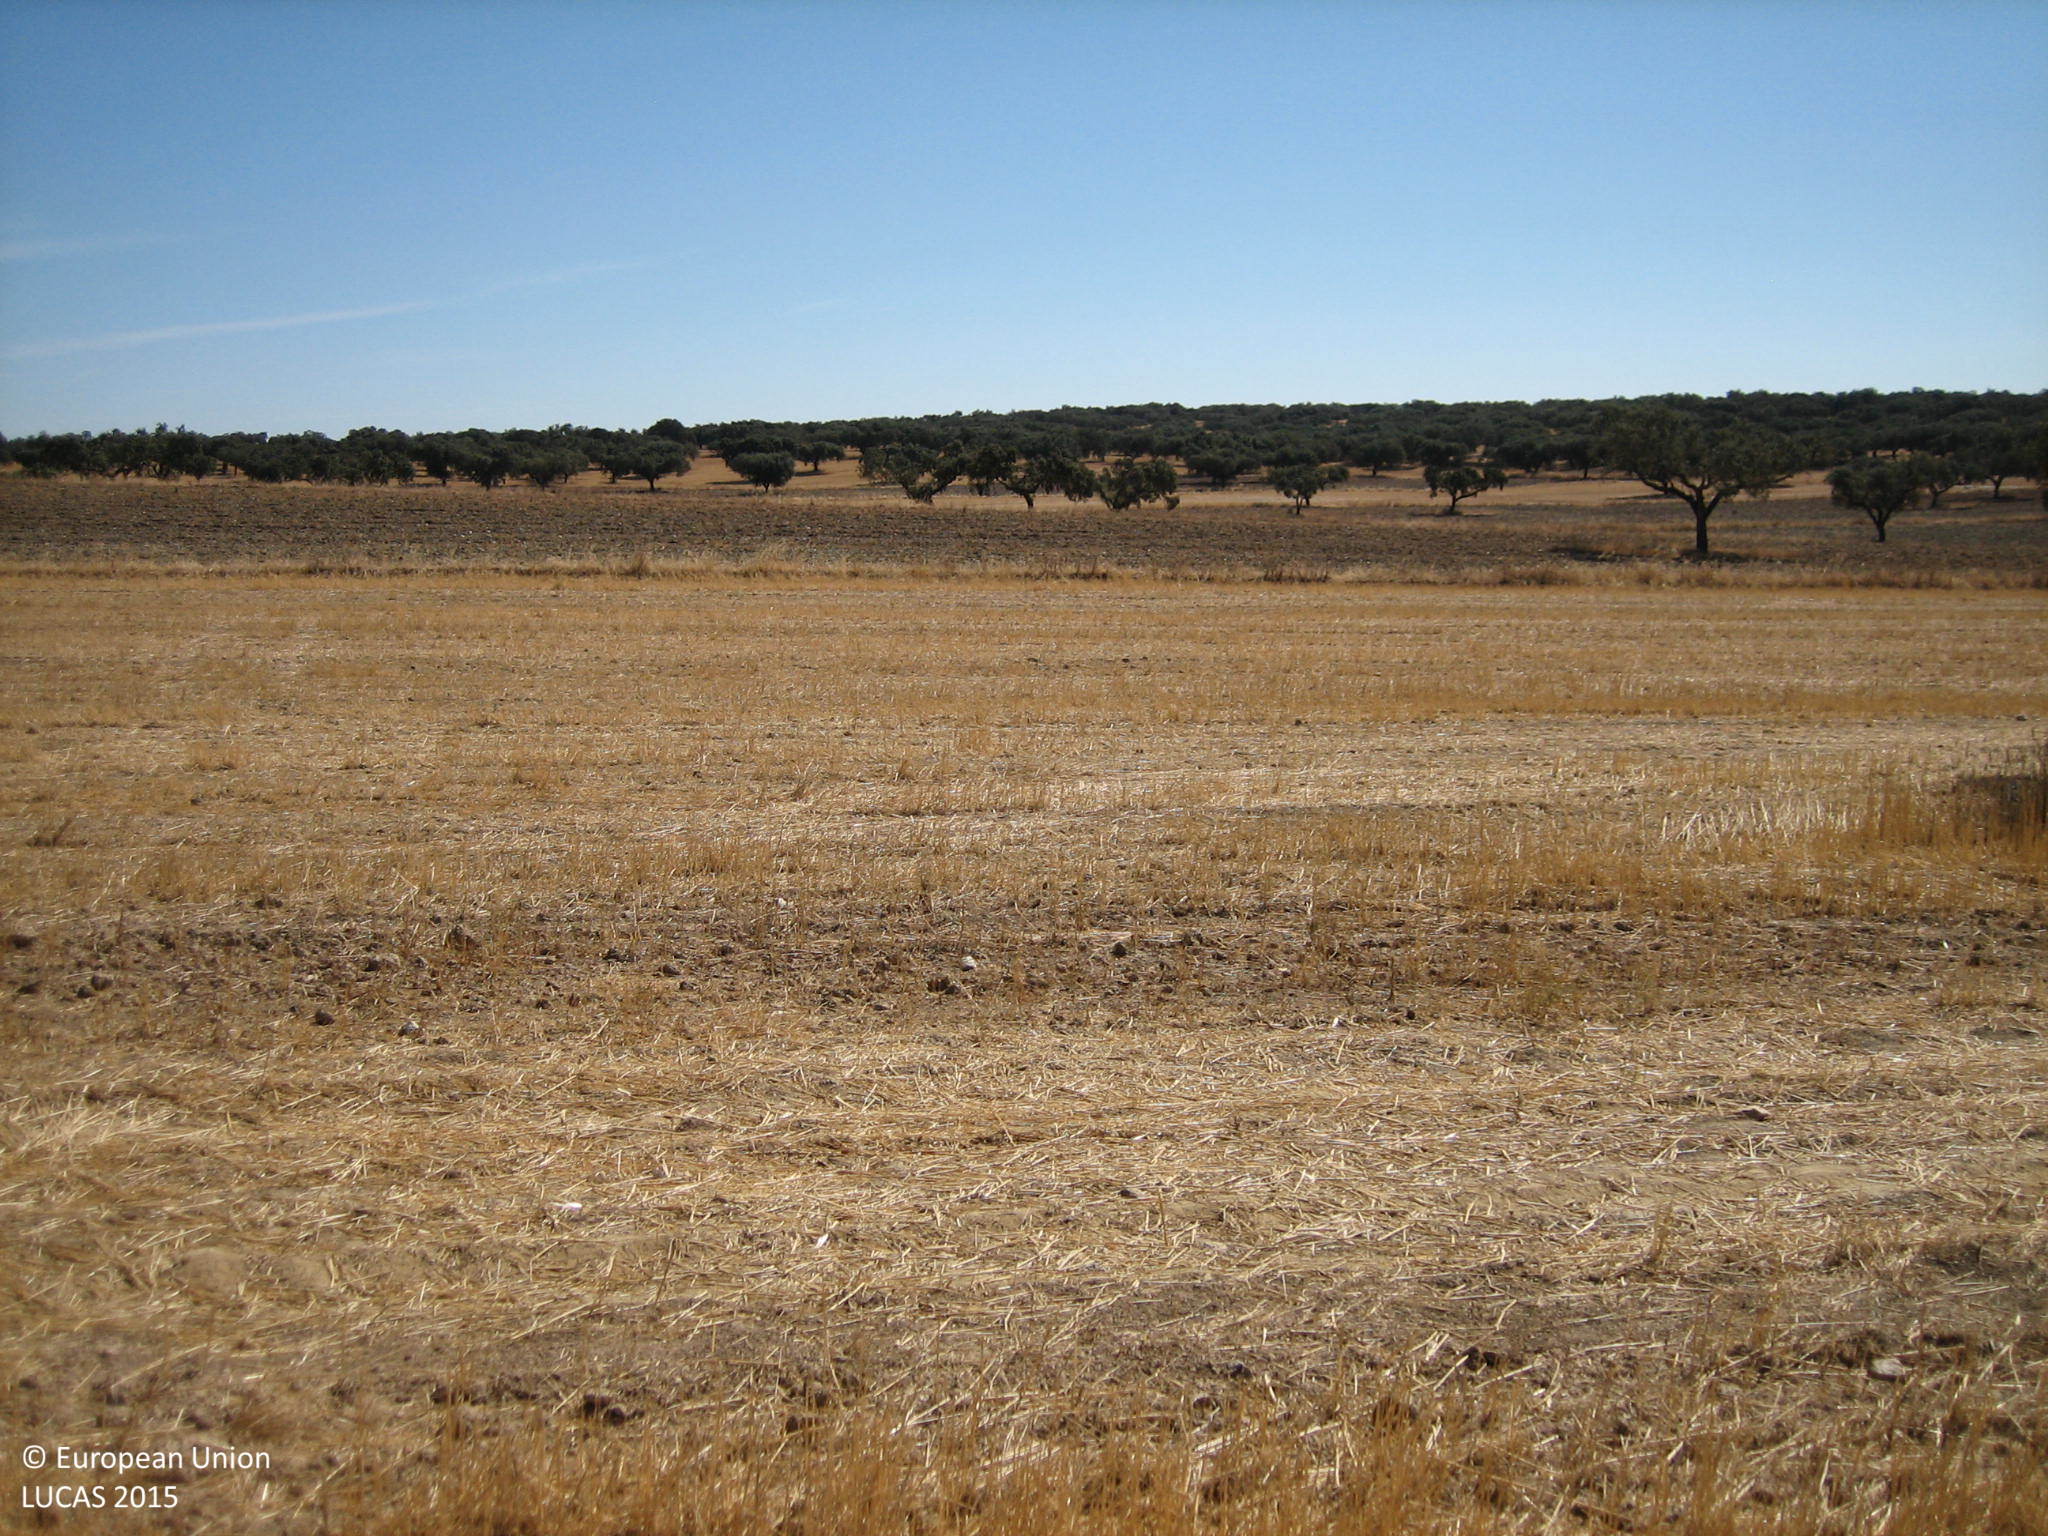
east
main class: Woodland
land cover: Broadleaved woodland
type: broadleaved evergreen forest
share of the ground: 10 - 25 %
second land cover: Grassland without tree/shrub cover
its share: > 75 %
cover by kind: herbaceous plants 80 %, broadleaved forest trees 20 %
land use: Forestry
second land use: Agriculture (excluding fallow land and kitchen gardens)
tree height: > 5 m
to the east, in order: Broadleaved woodland; Grassland without tree/shrub cover; Fences; Common wheat; Grass margins; Other bare soil; Grass margins; Other bare soil; Broadleaved woodland; Grass margins; Other bare soil
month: August
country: ES
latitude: 38.4193
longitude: -7.2125
